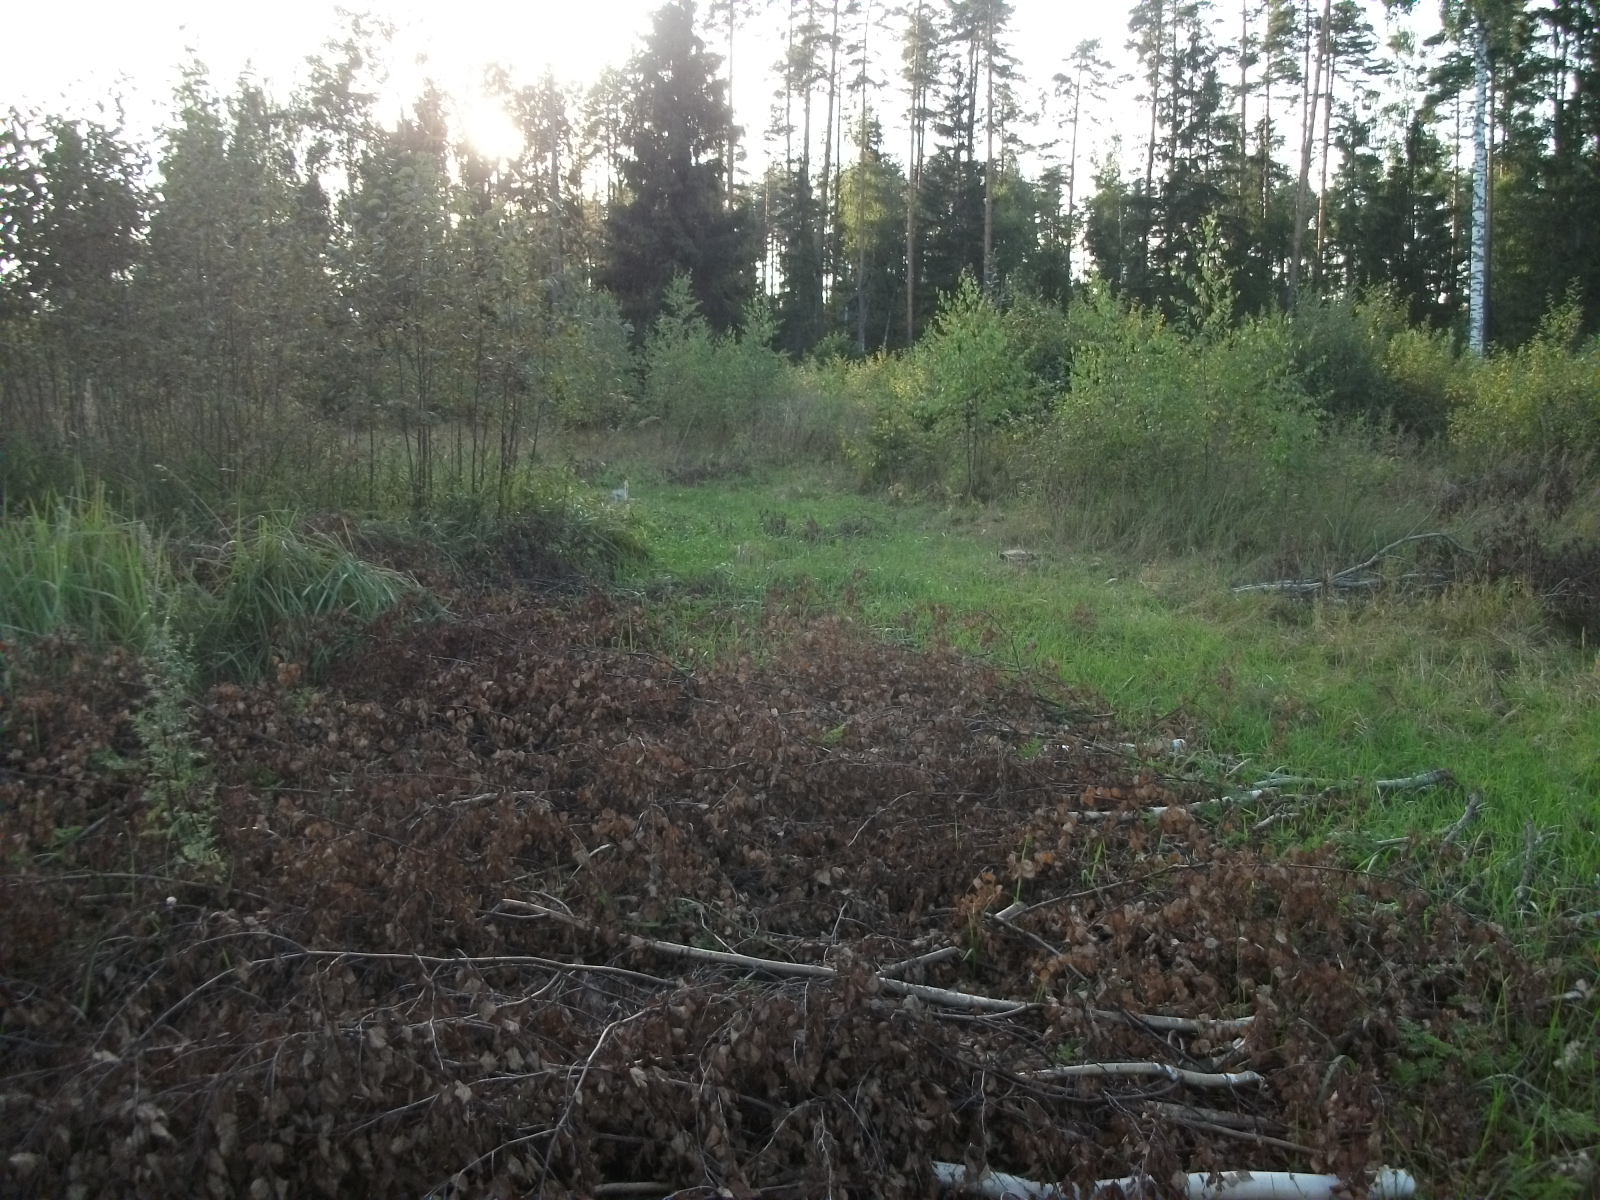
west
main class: Grassland
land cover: Spontaneously vegetated surfaces
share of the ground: > 75 %
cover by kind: herbaceous plants 95 %, shrubs 5 %
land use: Abandoned areas
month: August
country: LV
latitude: 56.4297
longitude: 26.2425
